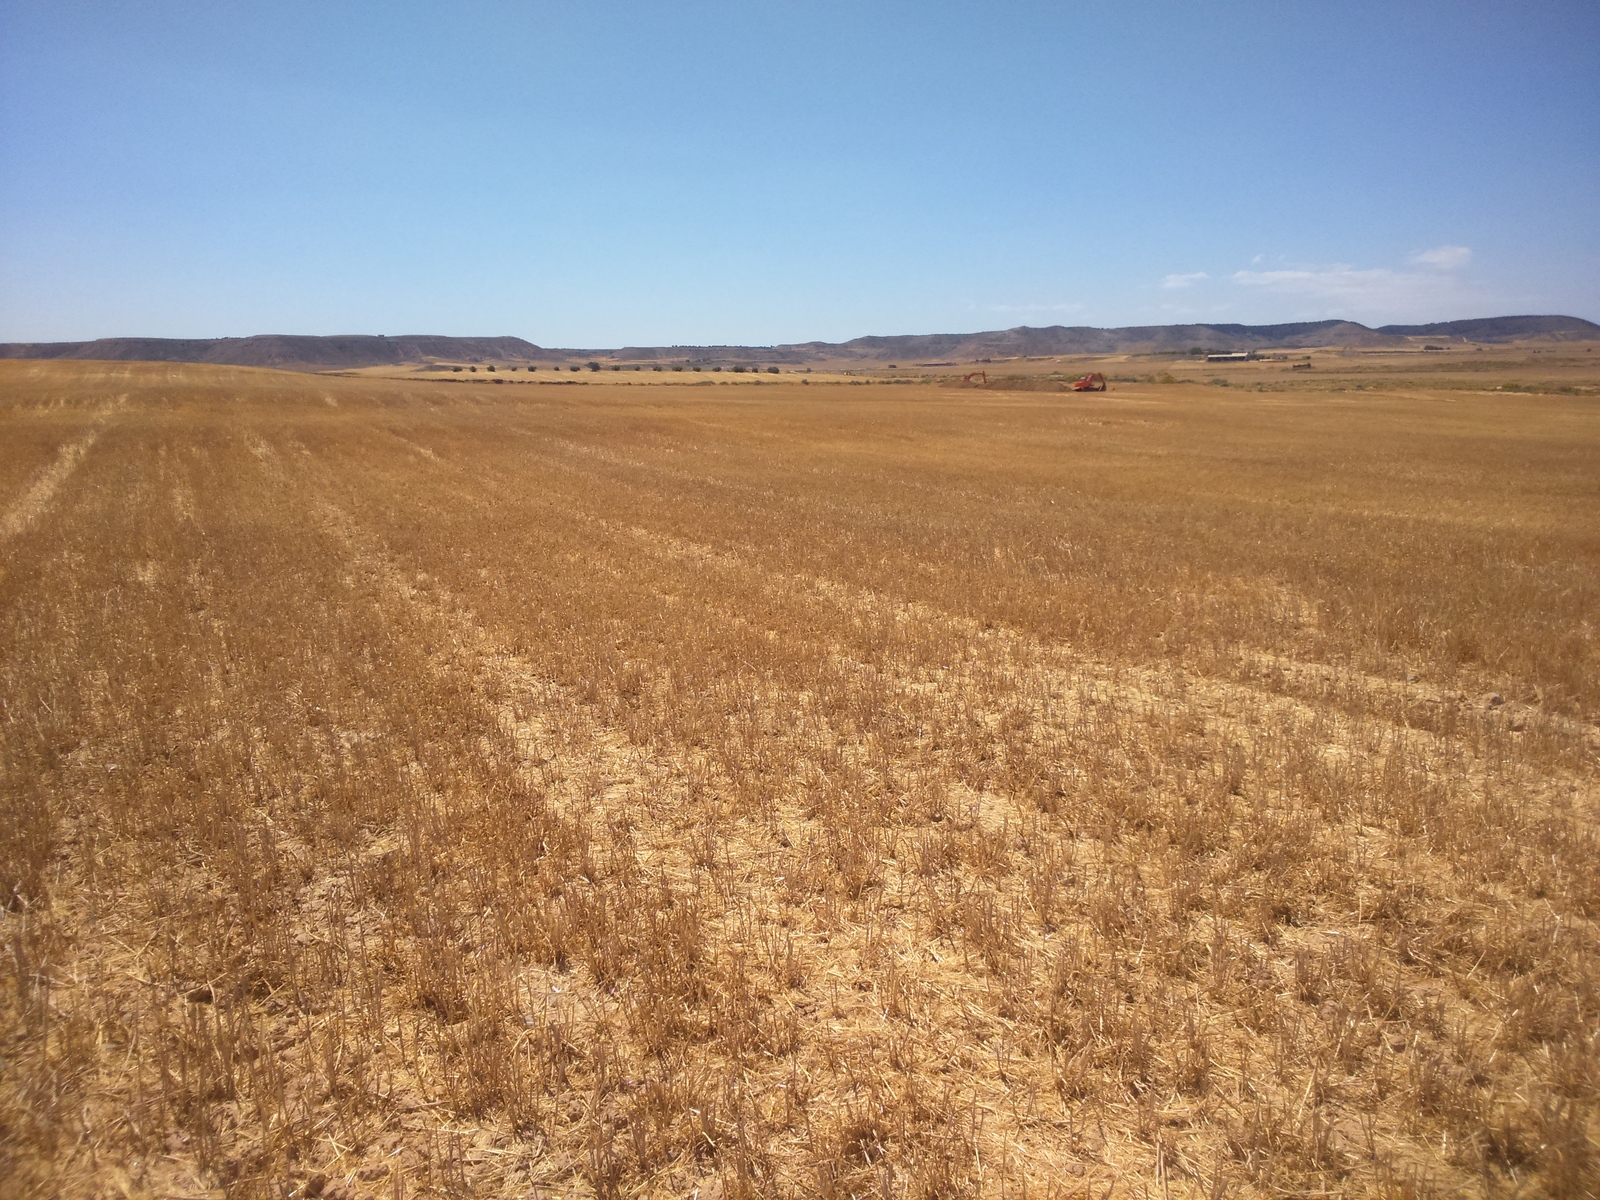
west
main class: Cropland
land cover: Barley
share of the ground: < 10 %
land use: Agriculture (excluding fallow land and kitchen gardens)
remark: Harvested field
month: June
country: ES
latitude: 41.5669
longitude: 0.0921
